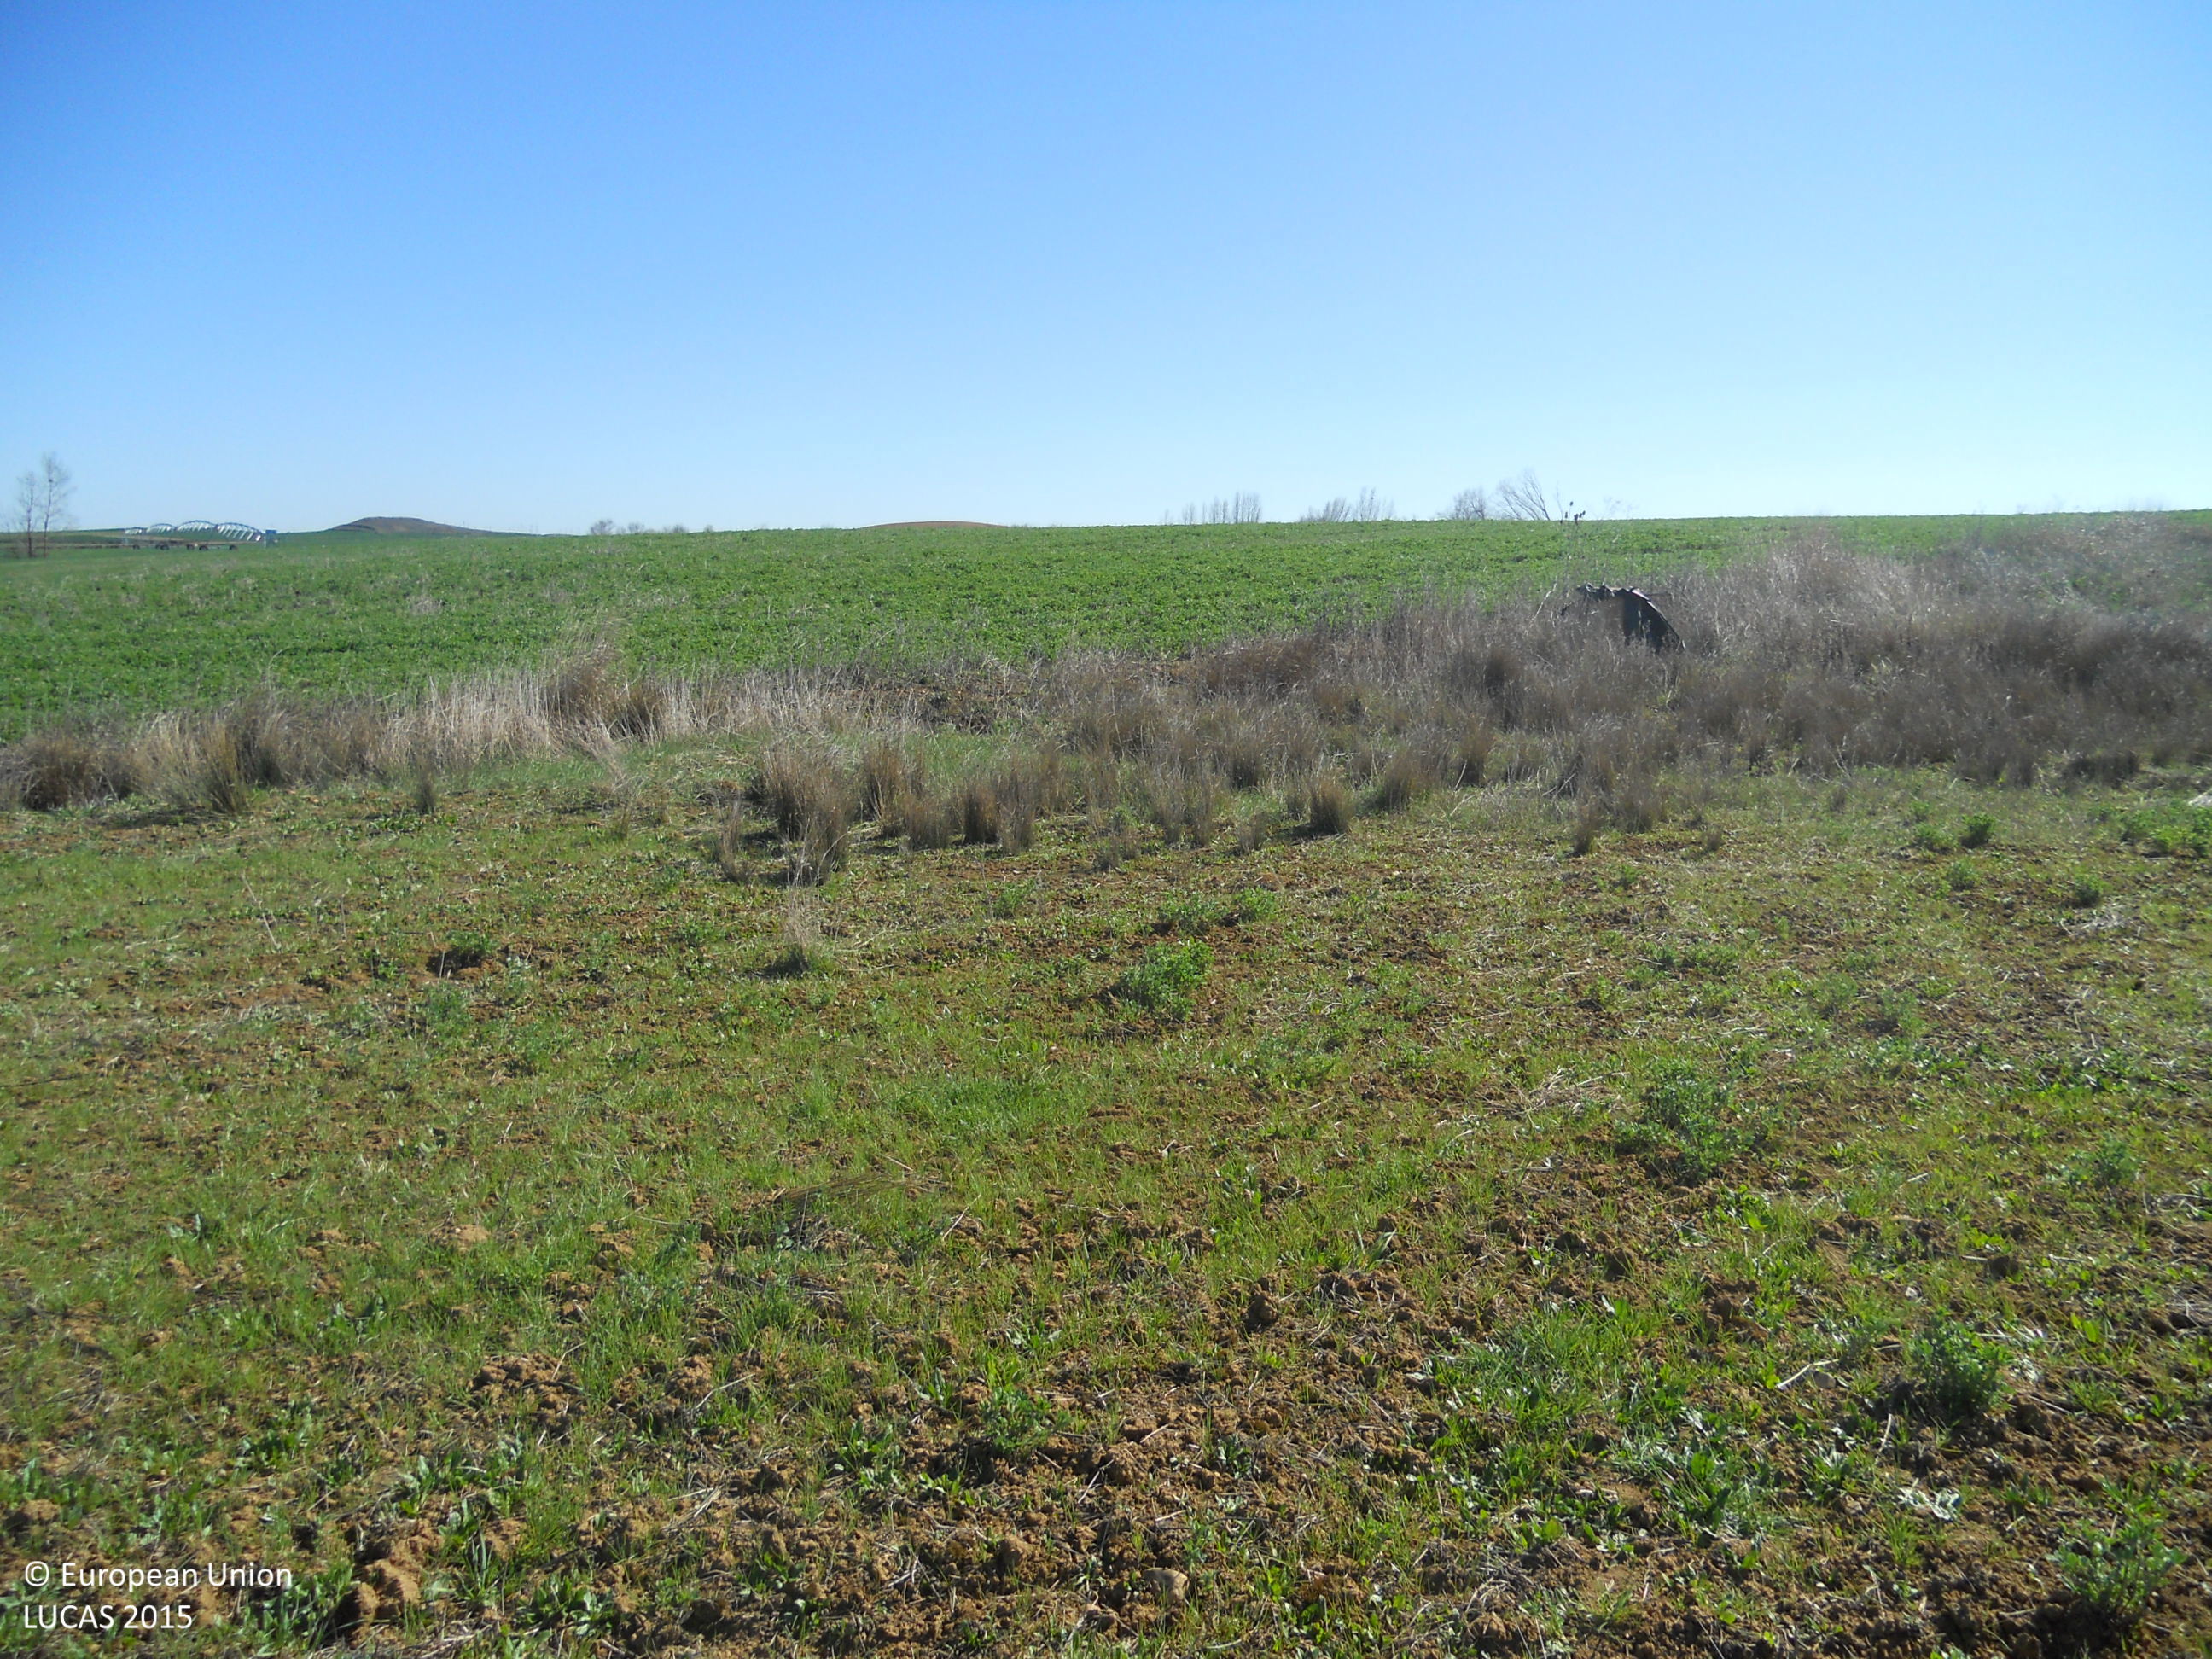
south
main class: Cropland
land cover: Lucerne
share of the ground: 50 - 75 %
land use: Agriculture (excluding fallow land and kitchen gardens)
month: April
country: ES
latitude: 42.3285
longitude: -4.3049
